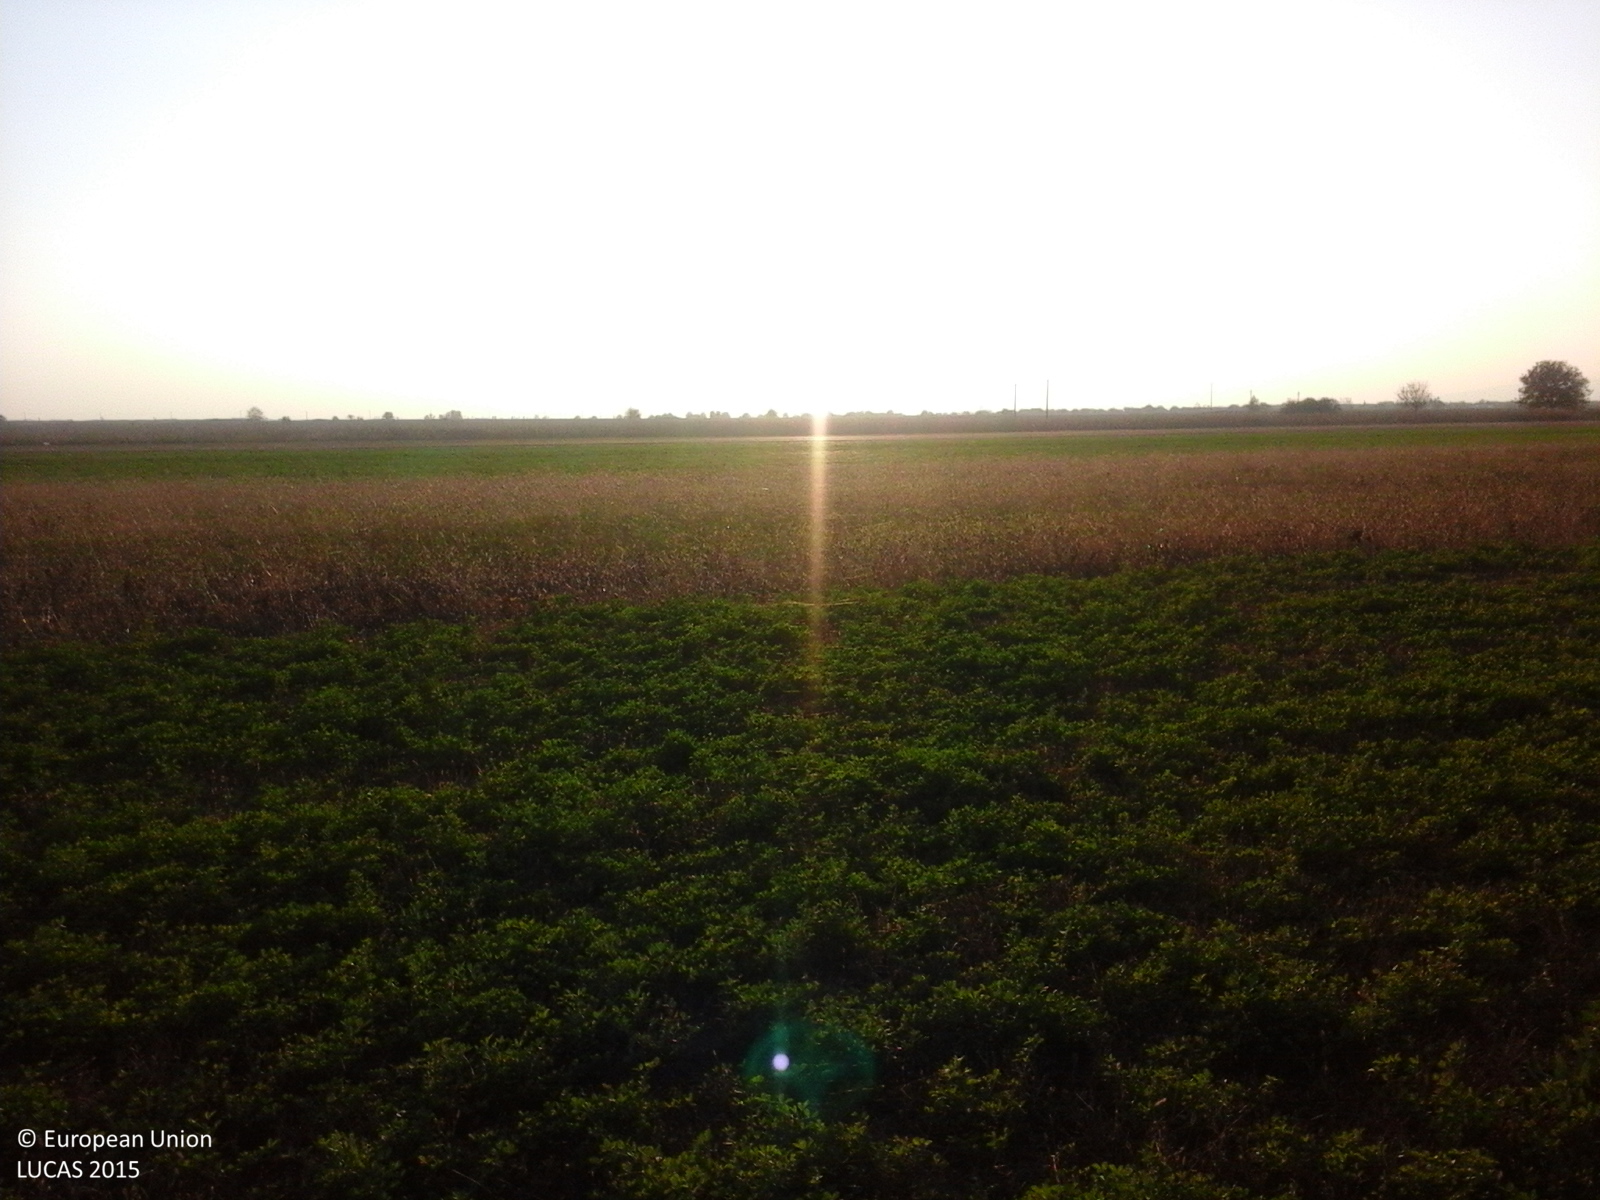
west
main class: Cropland
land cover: Lucerne
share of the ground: > 75 %
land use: Agriculture (excluding fallow land and kitchen gardens)
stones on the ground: < 10 %
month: October
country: RO
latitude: 45.1318
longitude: 26.9563
